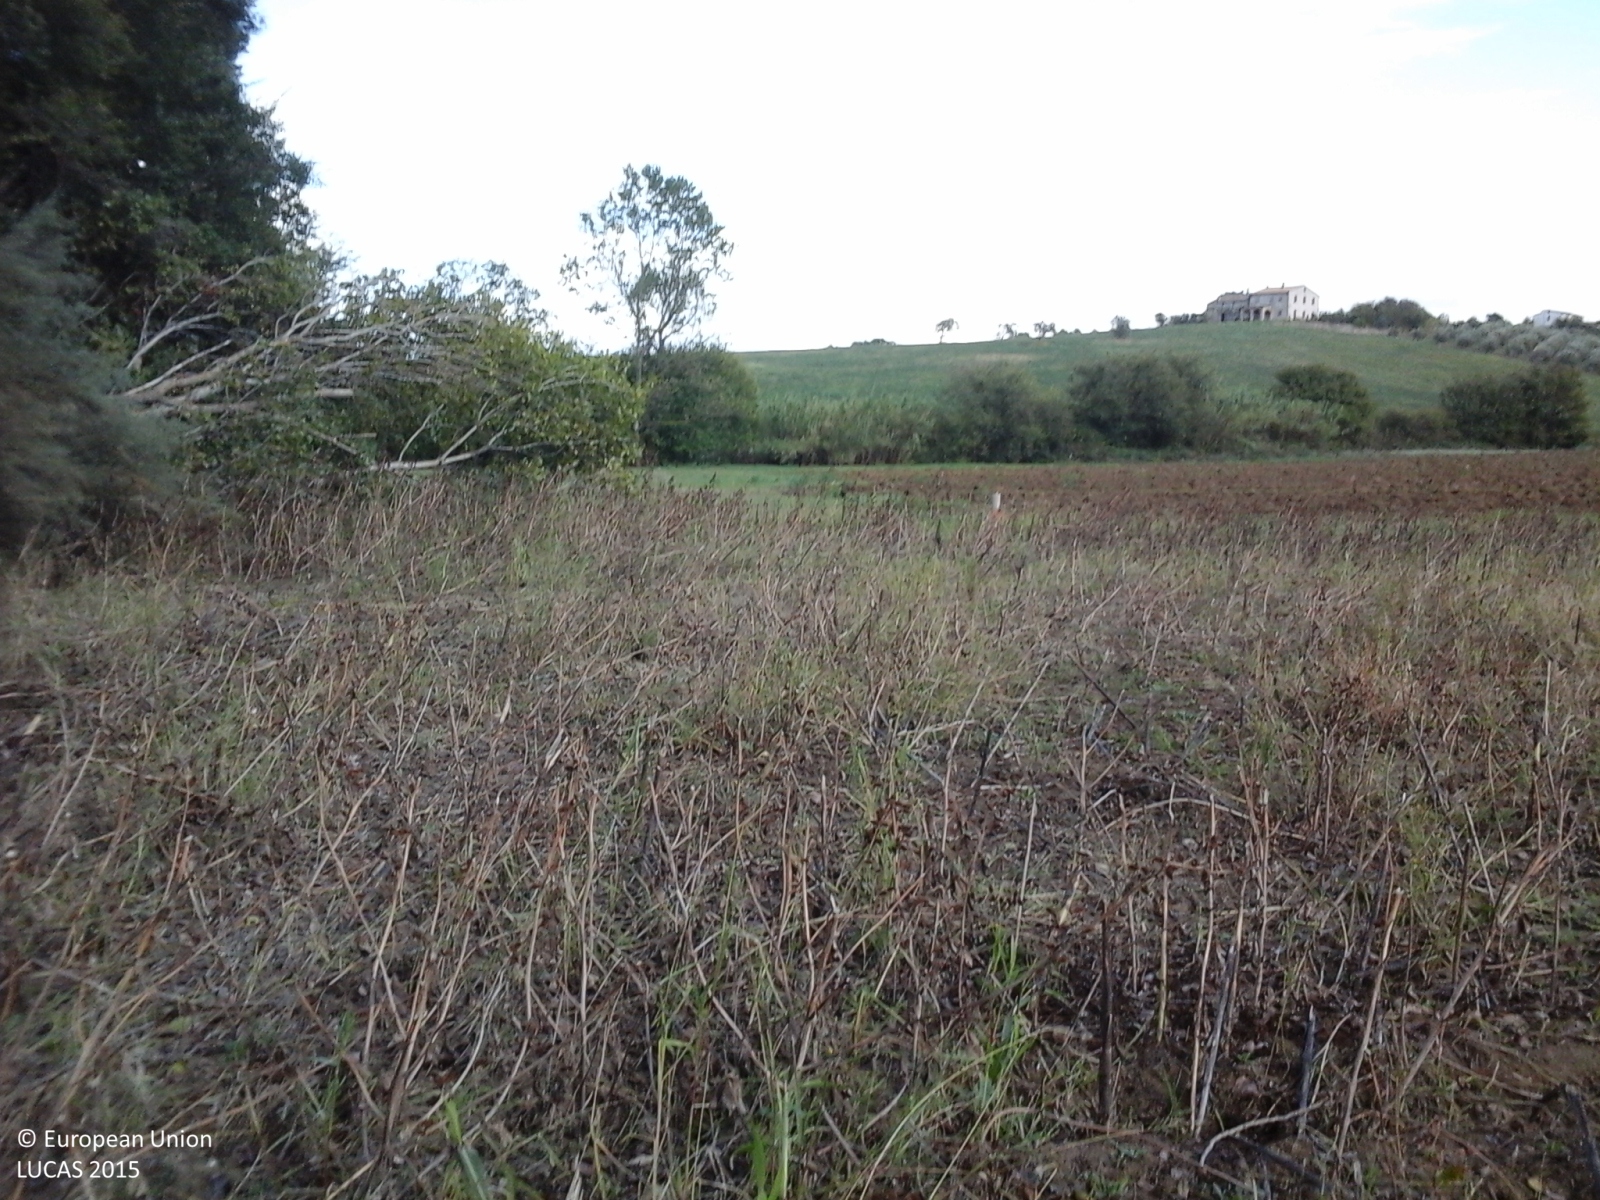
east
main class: Cropland
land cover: Sunflower
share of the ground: 25 - 50 %
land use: Agriculture (excluding fallow land and kitchen gardens)
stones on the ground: < 10 %
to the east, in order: Sunflower; Ditches and canals; Spontaneously vegetated surfaces; Ditches and canals; Abandoned hedges; Spontaneously vegetated surfaces
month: October
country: IT
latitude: 43.6489
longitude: 13.2777
